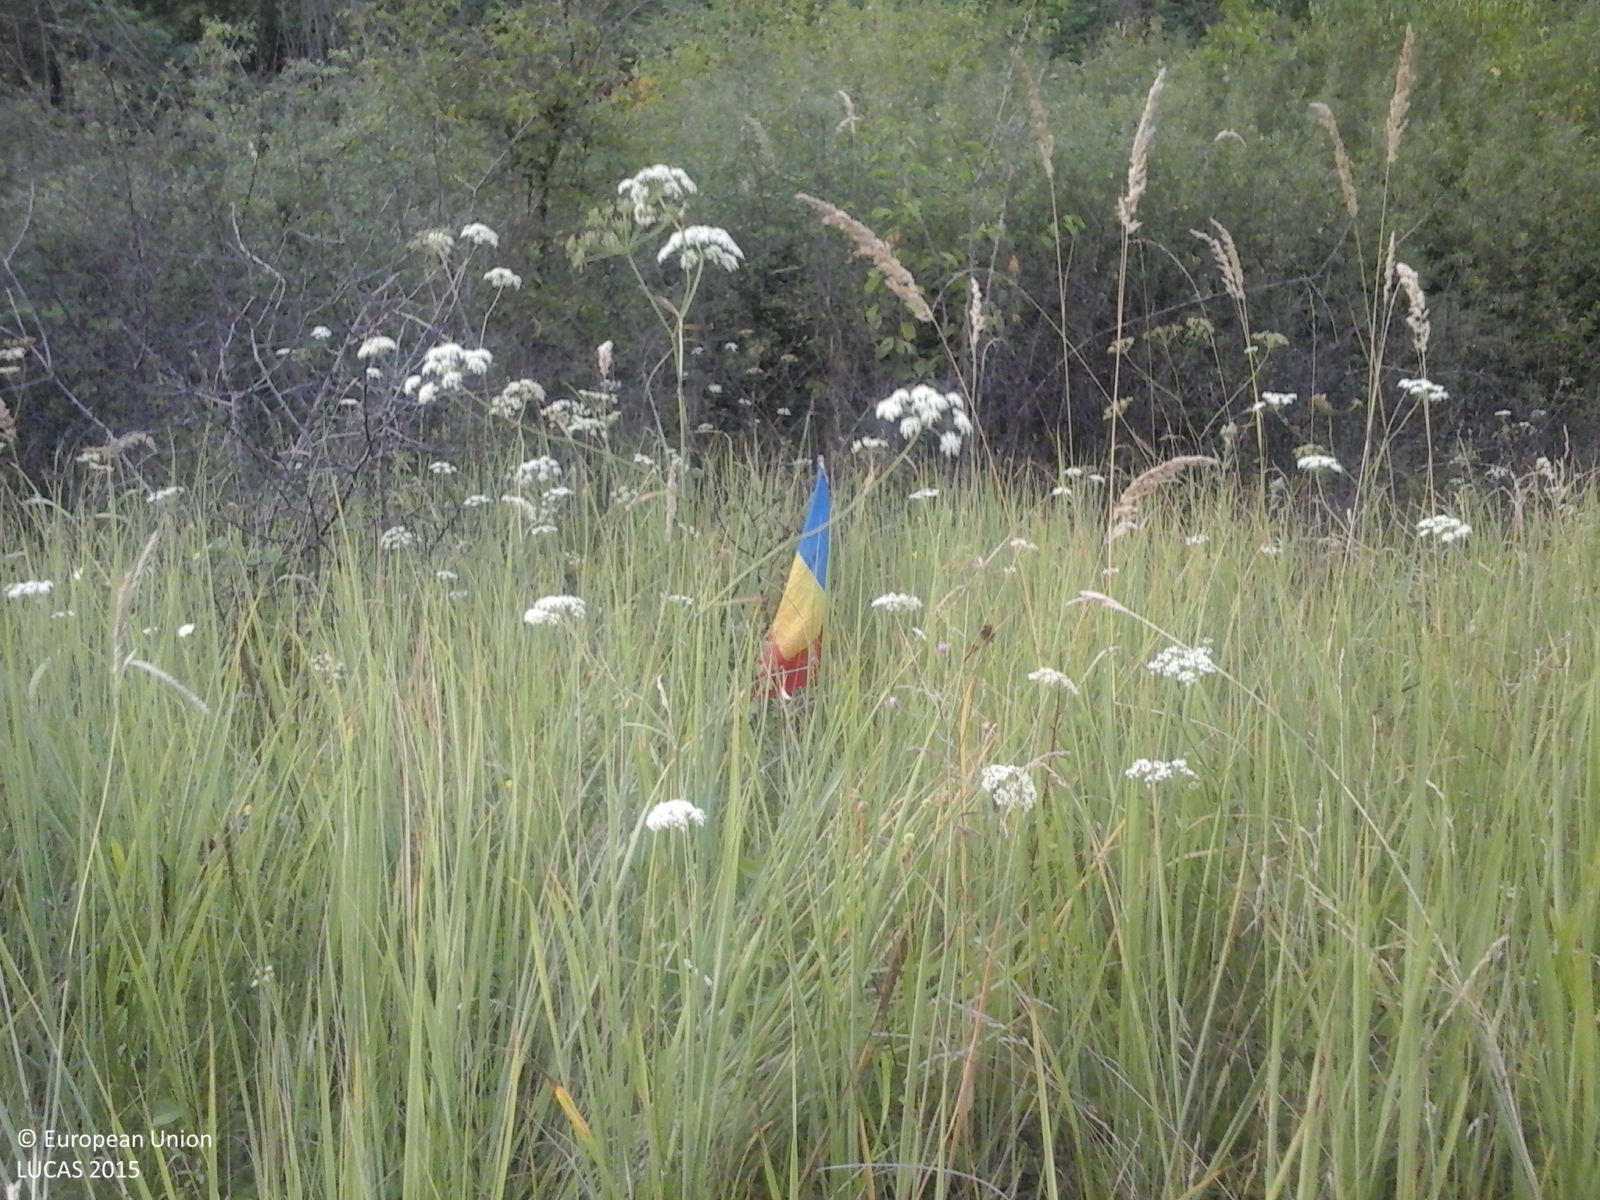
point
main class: Cropland
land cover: Apple fruit
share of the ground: 50 - 75 %
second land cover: Grassland without tree/shrub cover
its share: > 75 %
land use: Agriculture (excluding fallow land and kitchen gardens)
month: August
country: RO
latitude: 44.7461
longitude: 23.6094
